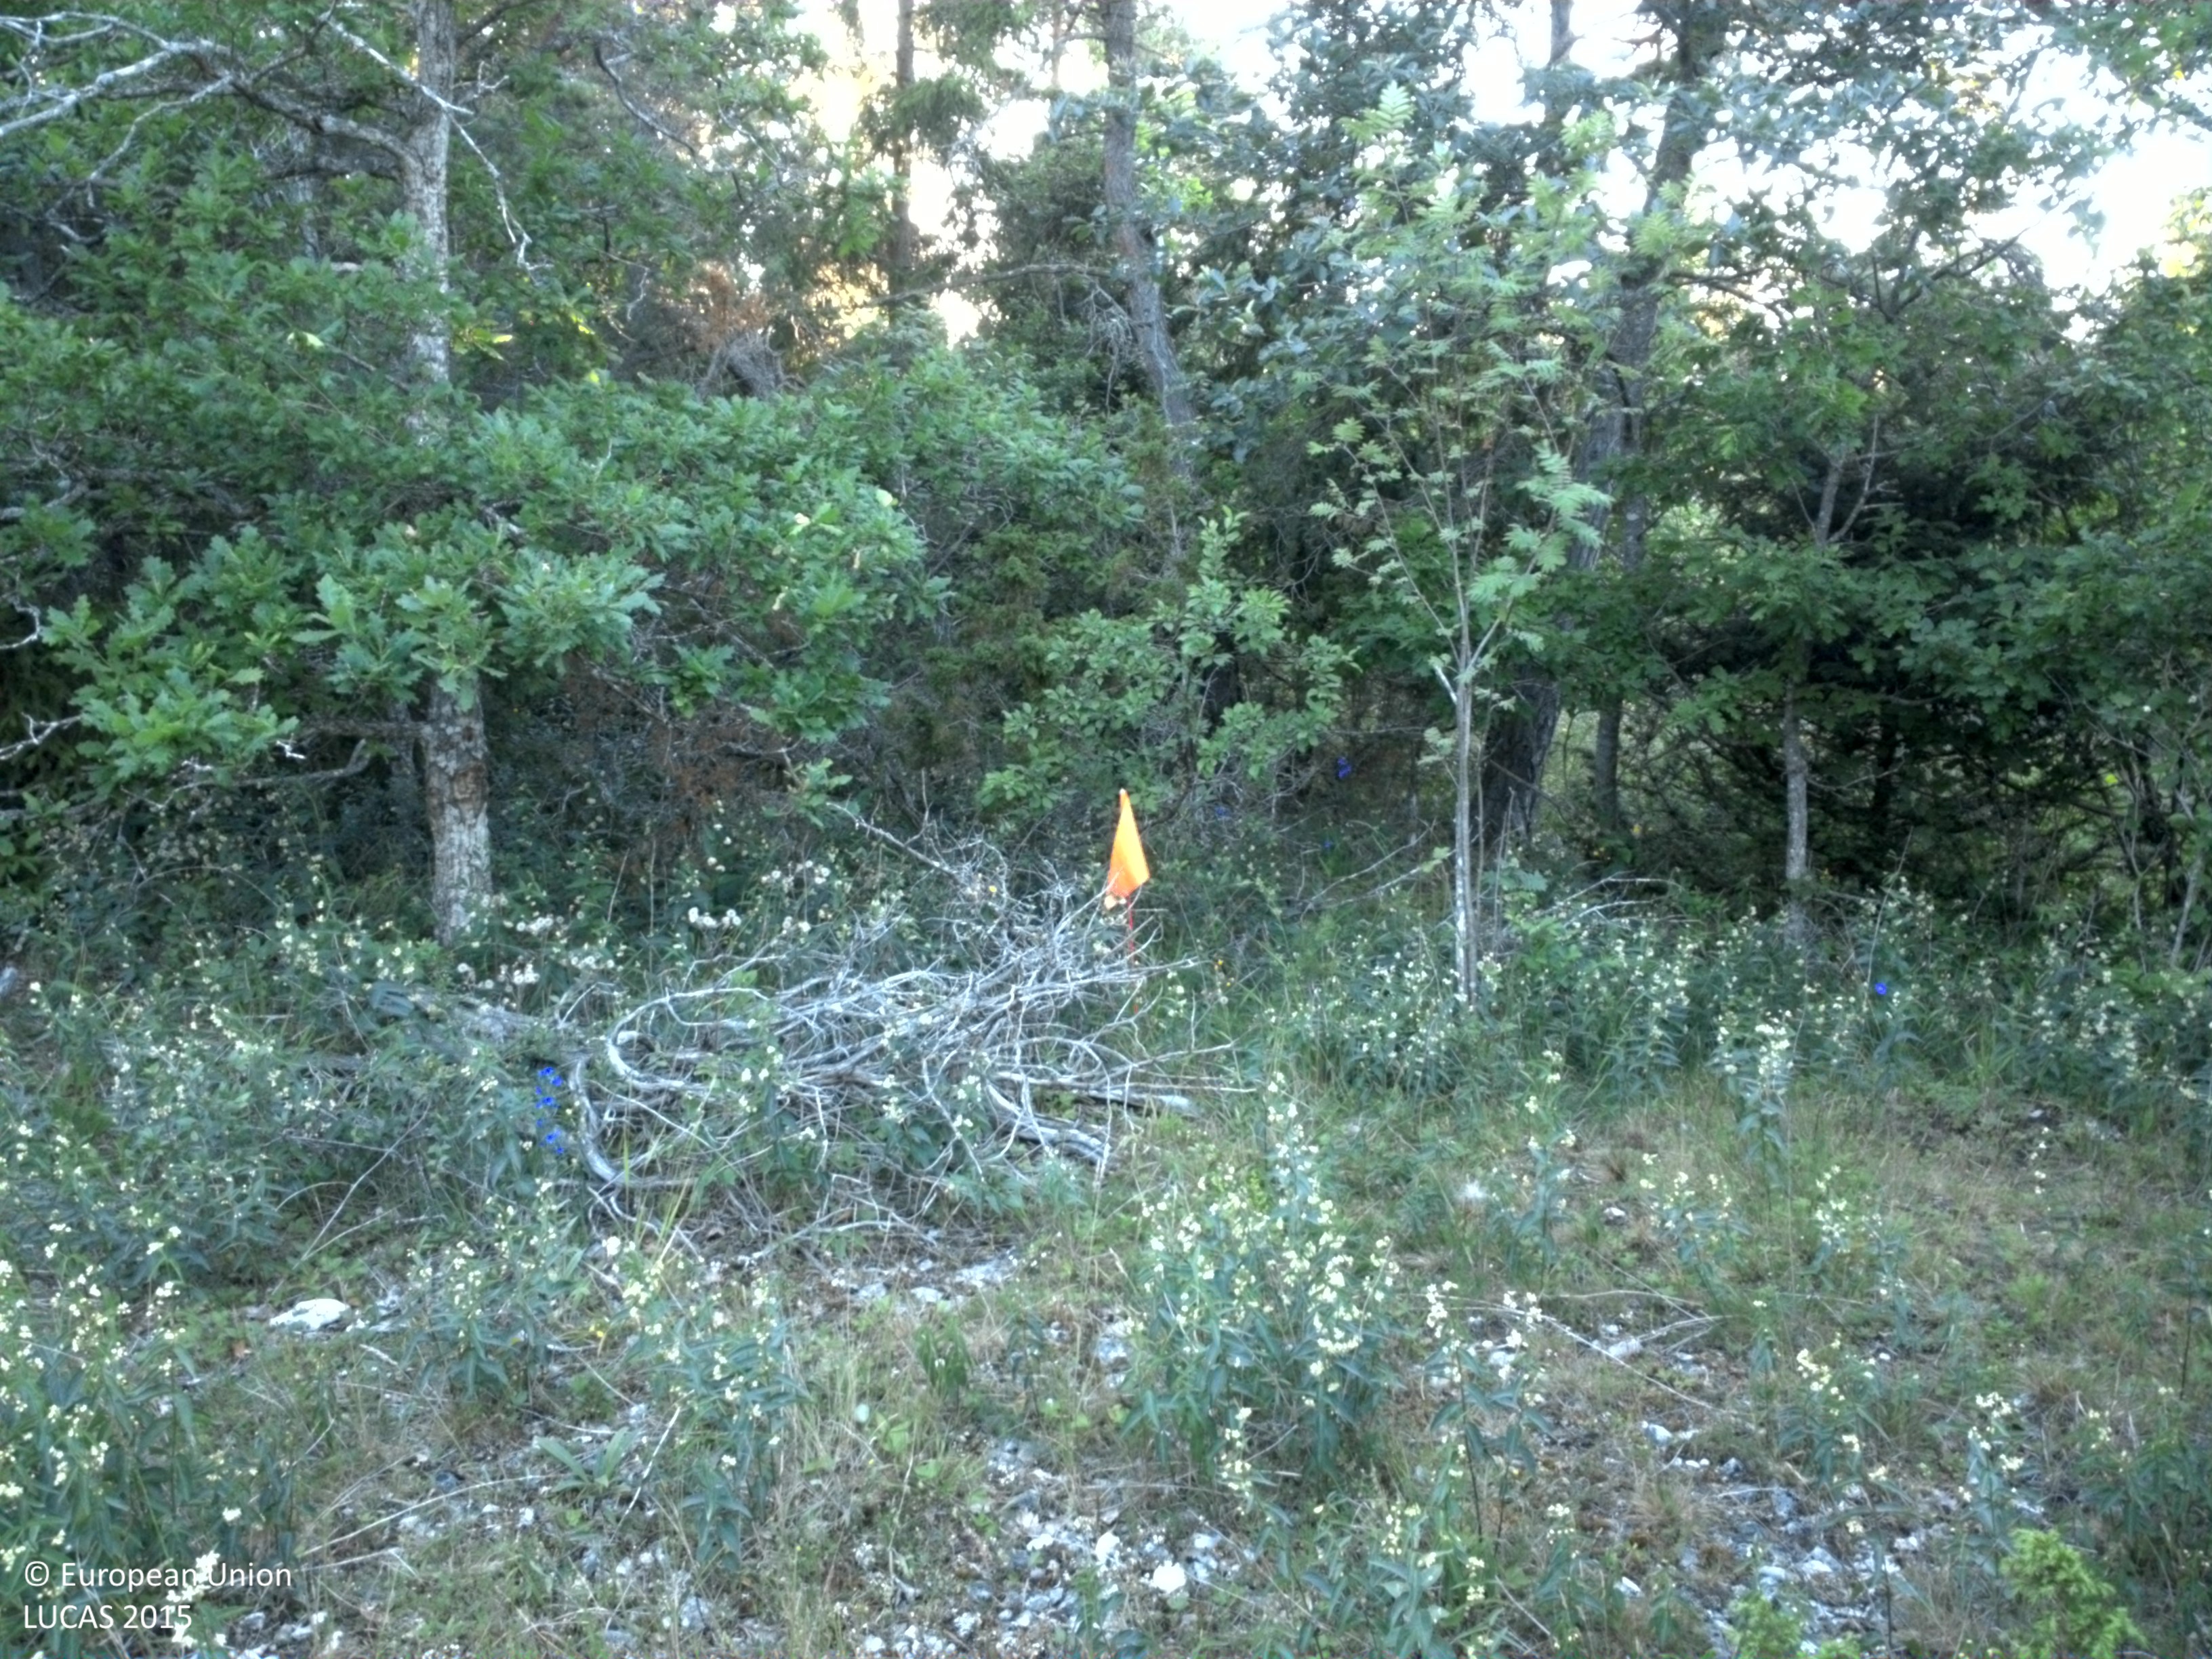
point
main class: Woodland
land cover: Pine dominated coniferous woodland
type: hemiboreal forest and nemoral coniferous forest and mixed broadleaved-coniferous forest
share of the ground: > 75 %
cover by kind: coniferous forest trees 80 %, herbaceous plants 10 %, broadleaved forest trees 5 %, shrubs 5 %
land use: Forestry
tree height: > 5 m
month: July
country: SE
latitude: 57.7497
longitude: 18.7972
